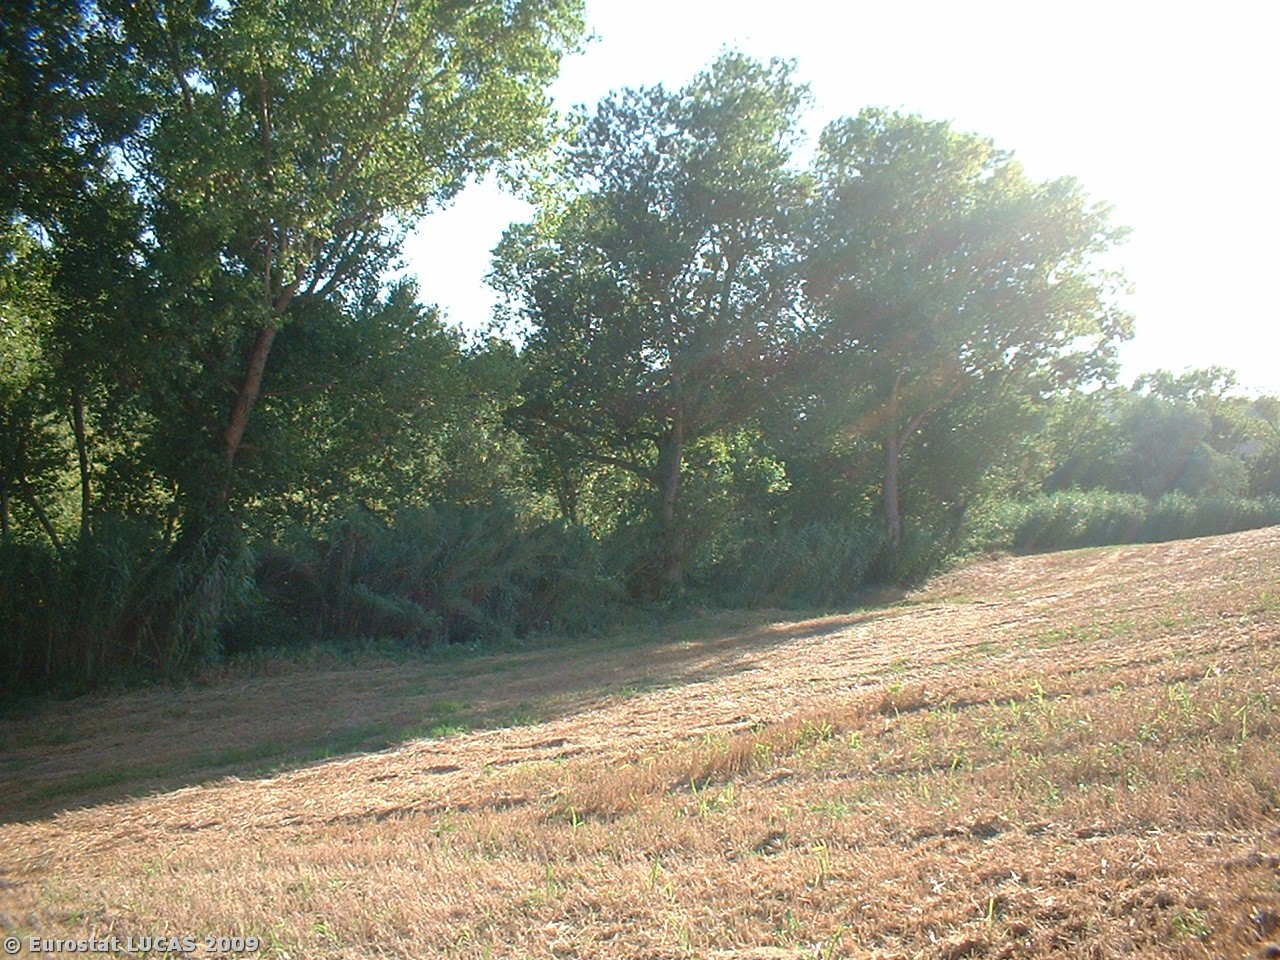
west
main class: Cropland
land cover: Durum wheat
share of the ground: < 10 %
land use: Agriculture (excluding fallow land and kitchen gardens)
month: July
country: IT
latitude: 43.6316
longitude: 13.2519
